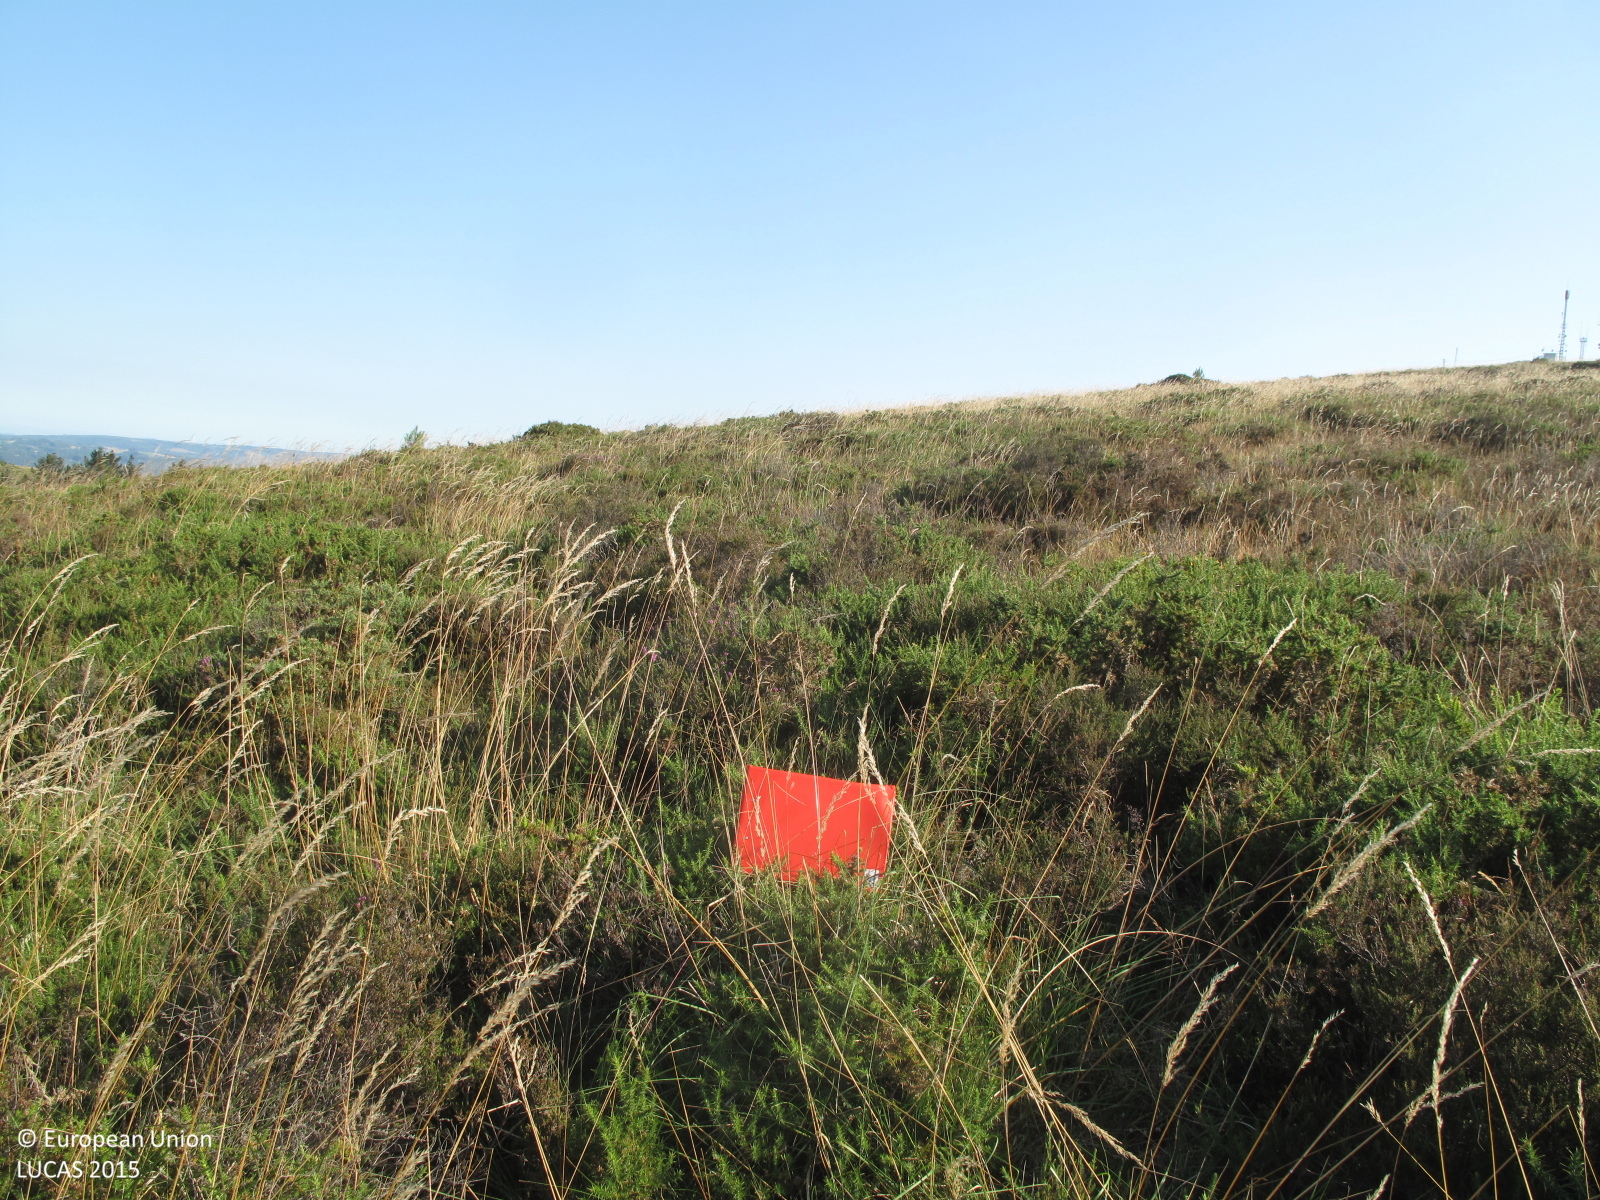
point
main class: Shrubland
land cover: Shrubland without tree cover
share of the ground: > 75 %
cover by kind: shrubs 95 %, herbaceous plants 5 %
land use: Semi-natural and natural areas not in use
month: July
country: ES
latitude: 43.4257
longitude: -7.9935
